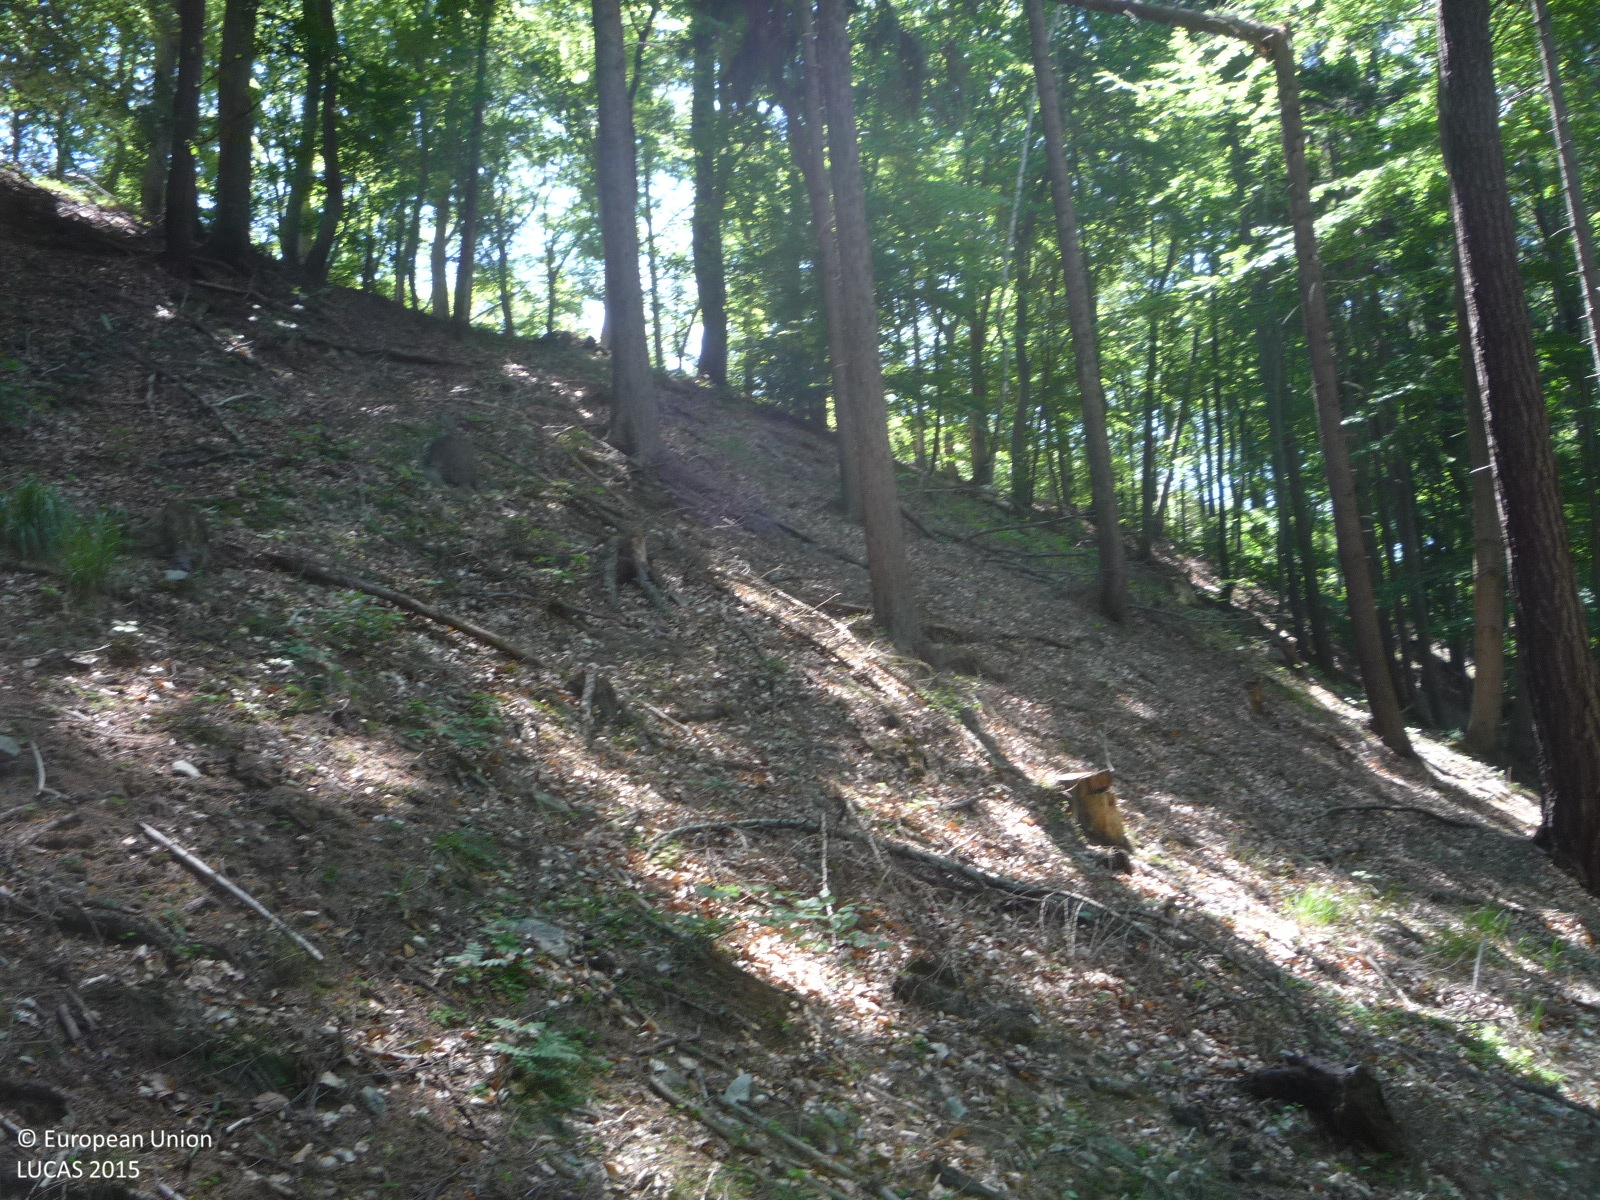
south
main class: Woodland
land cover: Spruce dominated mixed woodland
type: hemiboreal forest and nemoral coniferous forest and mixed broadleaved-coniferous forest
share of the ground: > 75 %
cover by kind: coniferous forest trees 60 %, broadleaved forest trees 30 %, lichens and mosses 5 %, unconsolidated bare surface 5 %
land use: Forestry
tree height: > 5 m
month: June
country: CZ
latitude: 50.2280
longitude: 13.8276
